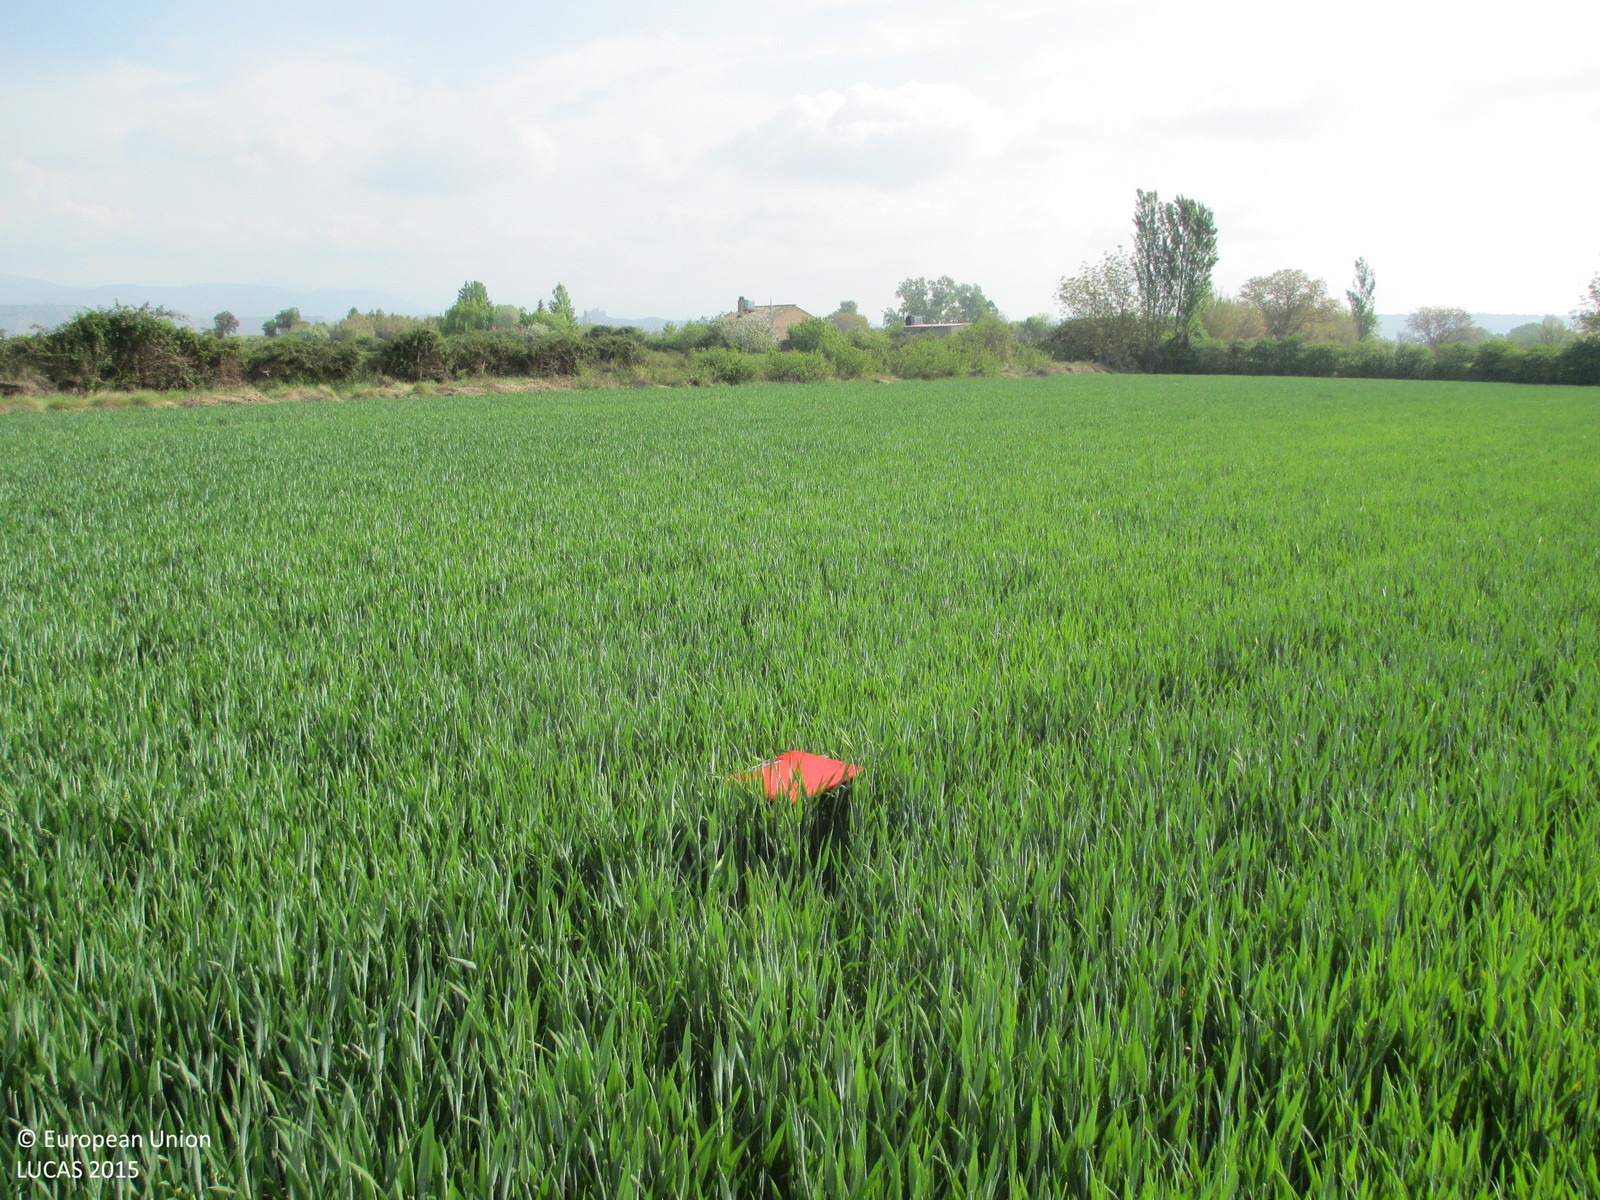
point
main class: Cropland
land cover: Durum wheat
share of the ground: > 75 %
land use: Agriculture (excluding fallow land and kitchen gardens)
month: April
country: ES
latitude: 42.1185
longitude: -0.3879
